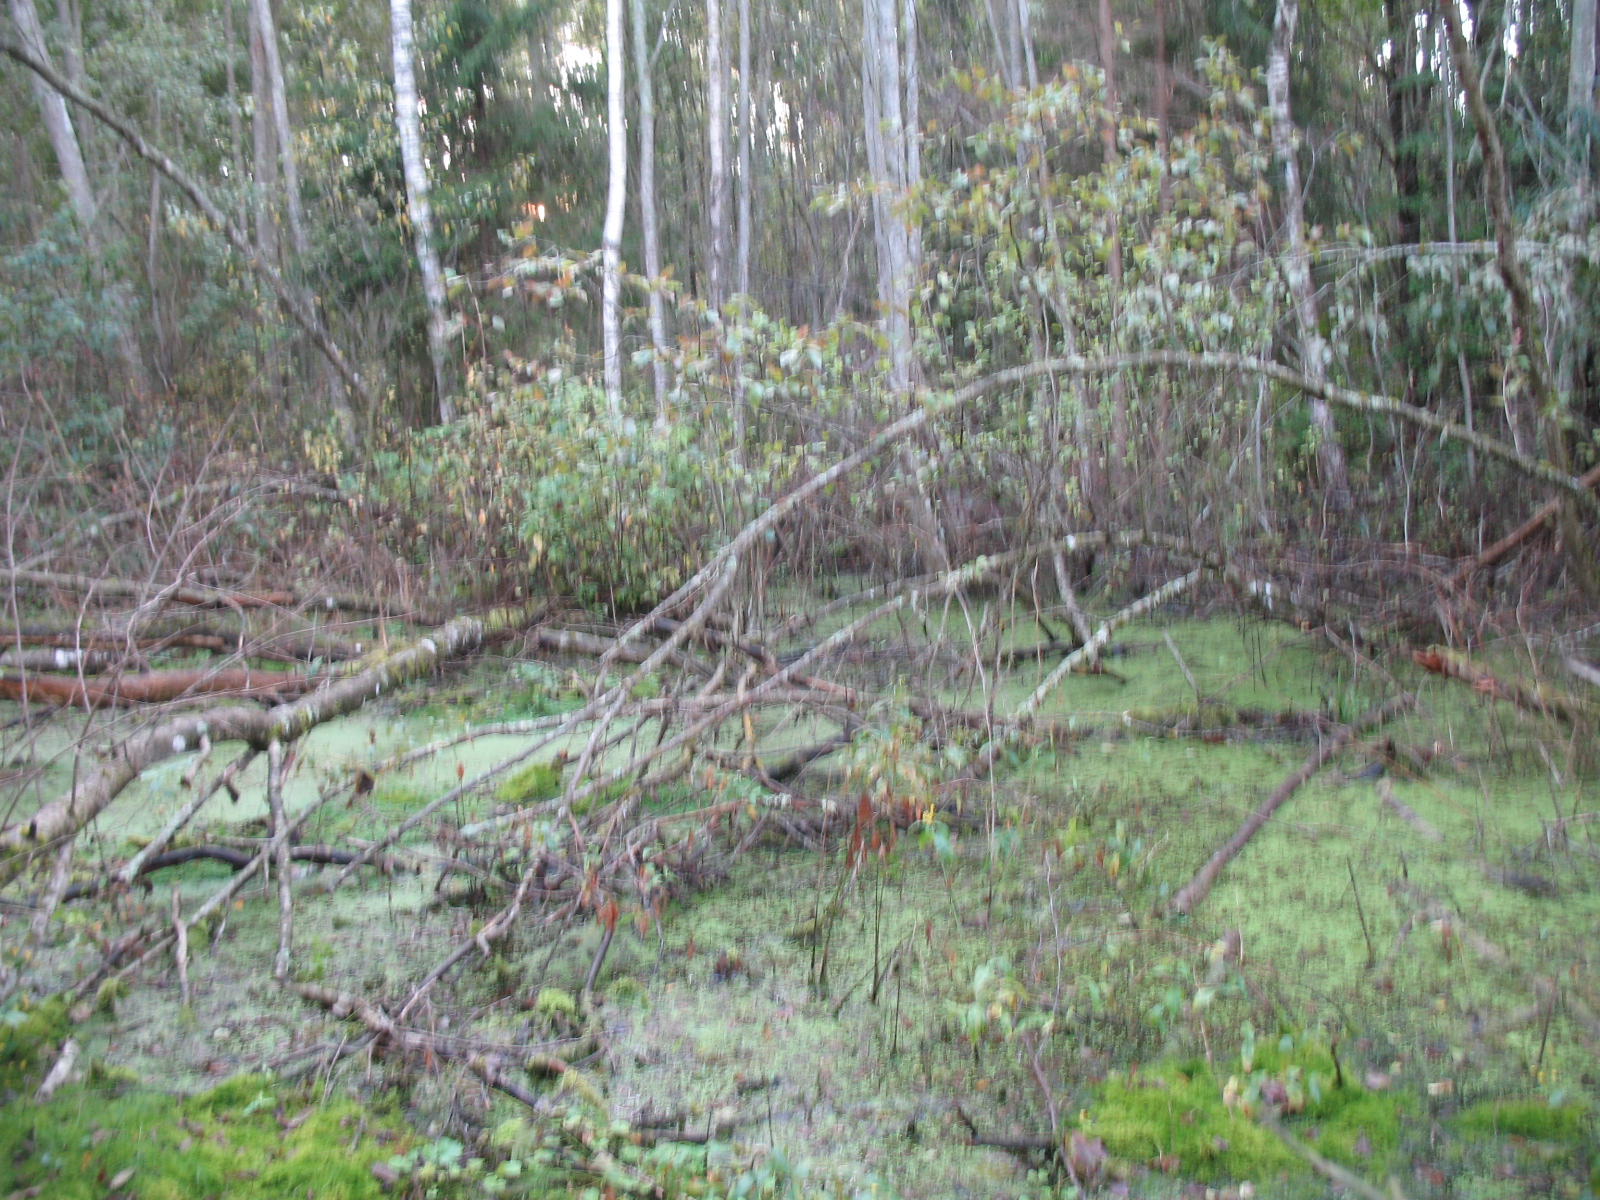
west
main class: Woodland
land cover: Broadleaved woodland
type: floodplain forest
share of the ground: > 75 %
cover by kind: broadleaved forest trees 80 %, herbaceous plants 10 %, lichens and mosses 5 %
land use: Forestry
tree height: > 5 m
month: September
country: LV
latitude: 56.1611
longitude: 25.8959
